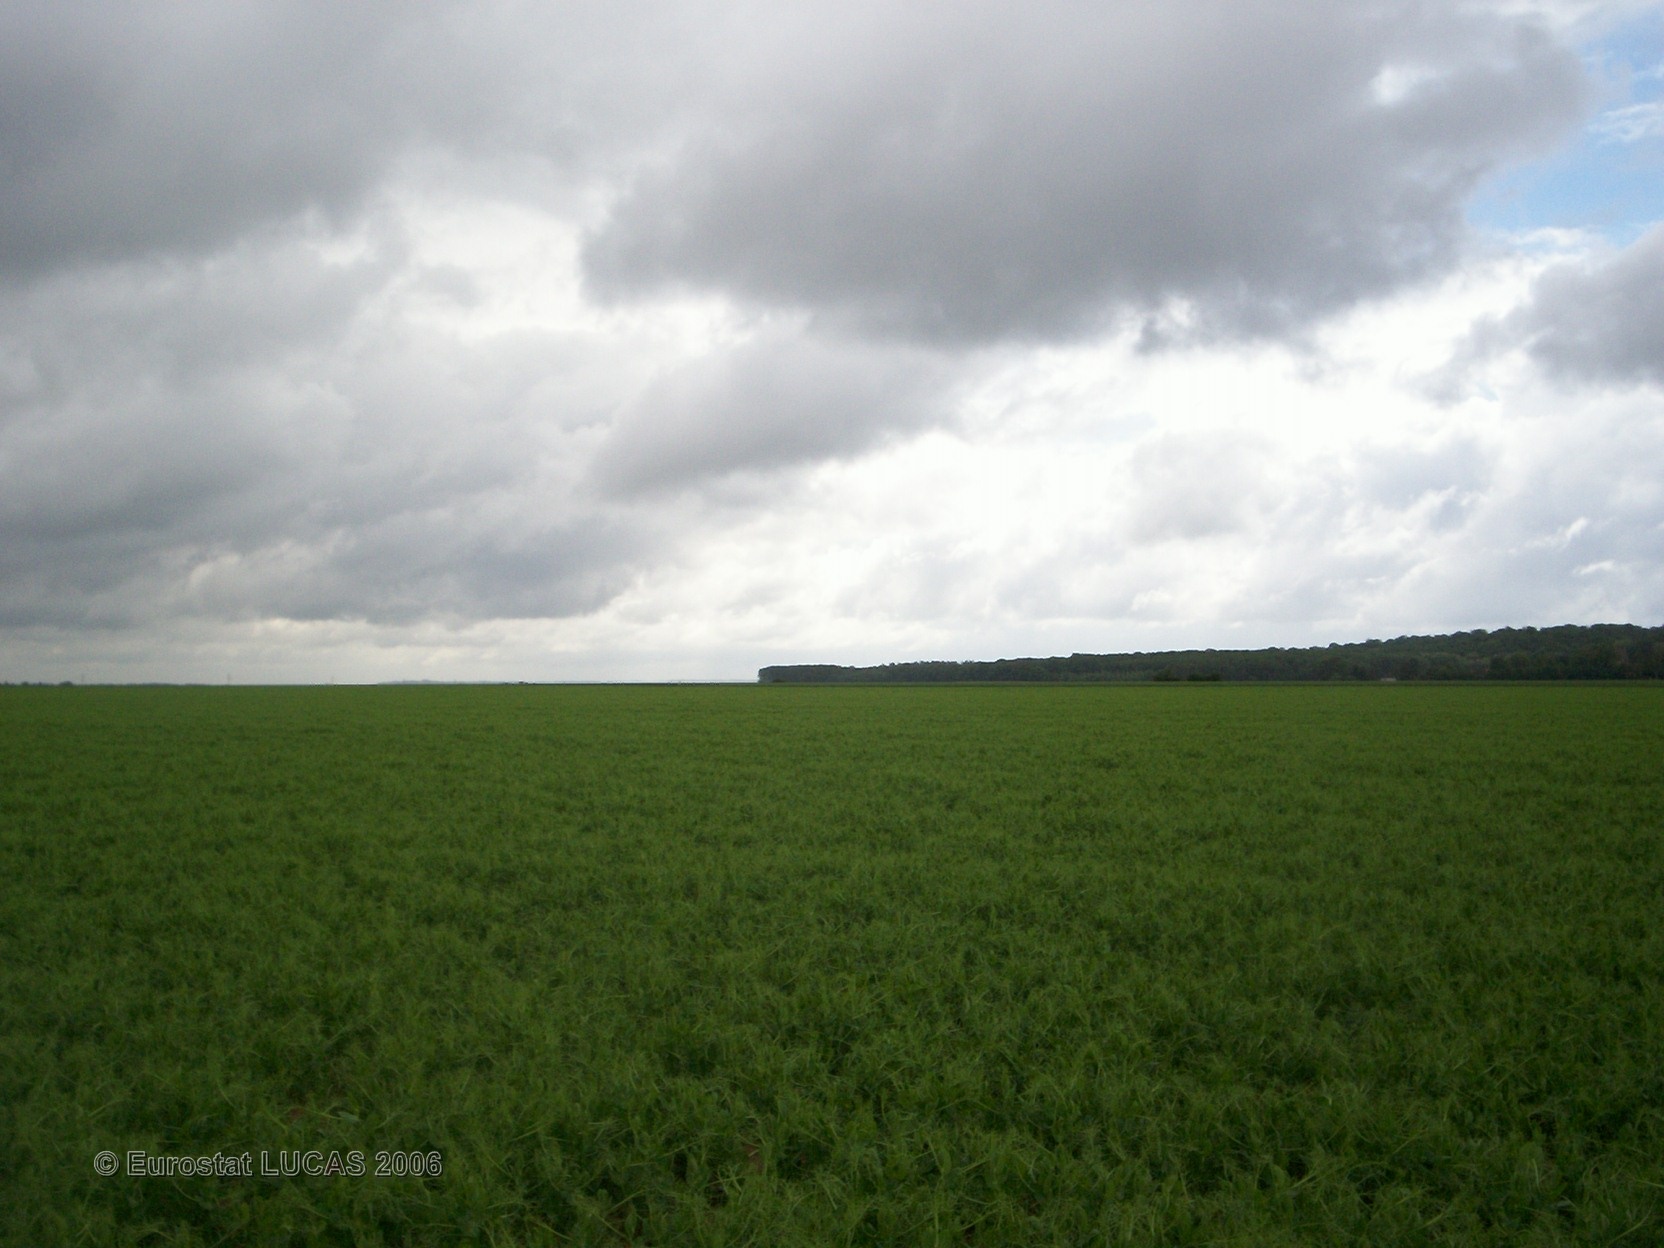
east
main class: Cropland
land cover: Dry pulses
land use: Agriculture (excluding fallow land and kitchen gardens)
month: May
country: FR
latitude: 49.2670
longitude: 2.7472
